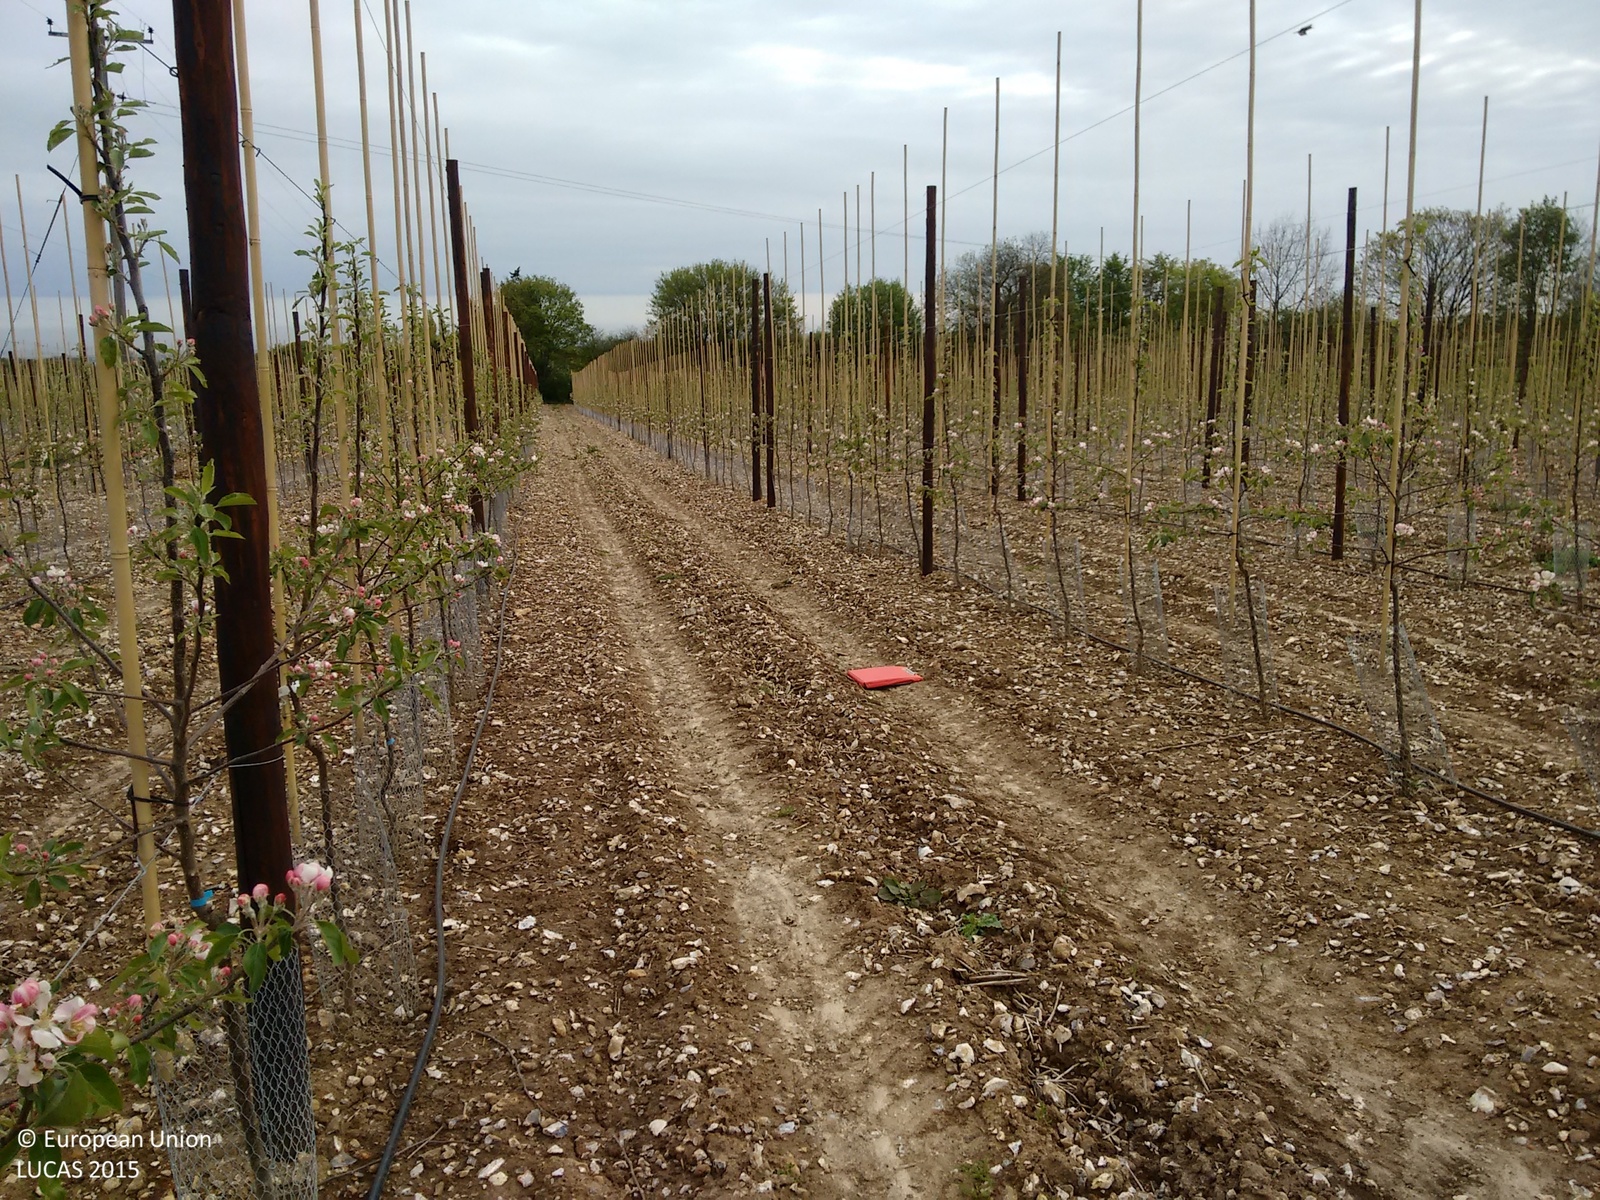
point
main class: Cropland
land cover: Apple fruit
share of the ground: 10 - 25 %
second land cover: Other bare soil
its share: > 75 %
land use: Agriculture (excluding fallow land and kitchen gardens)
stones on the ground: 25 - 50 %
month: May
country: GB
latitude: 51.2897
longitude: 0.7253
